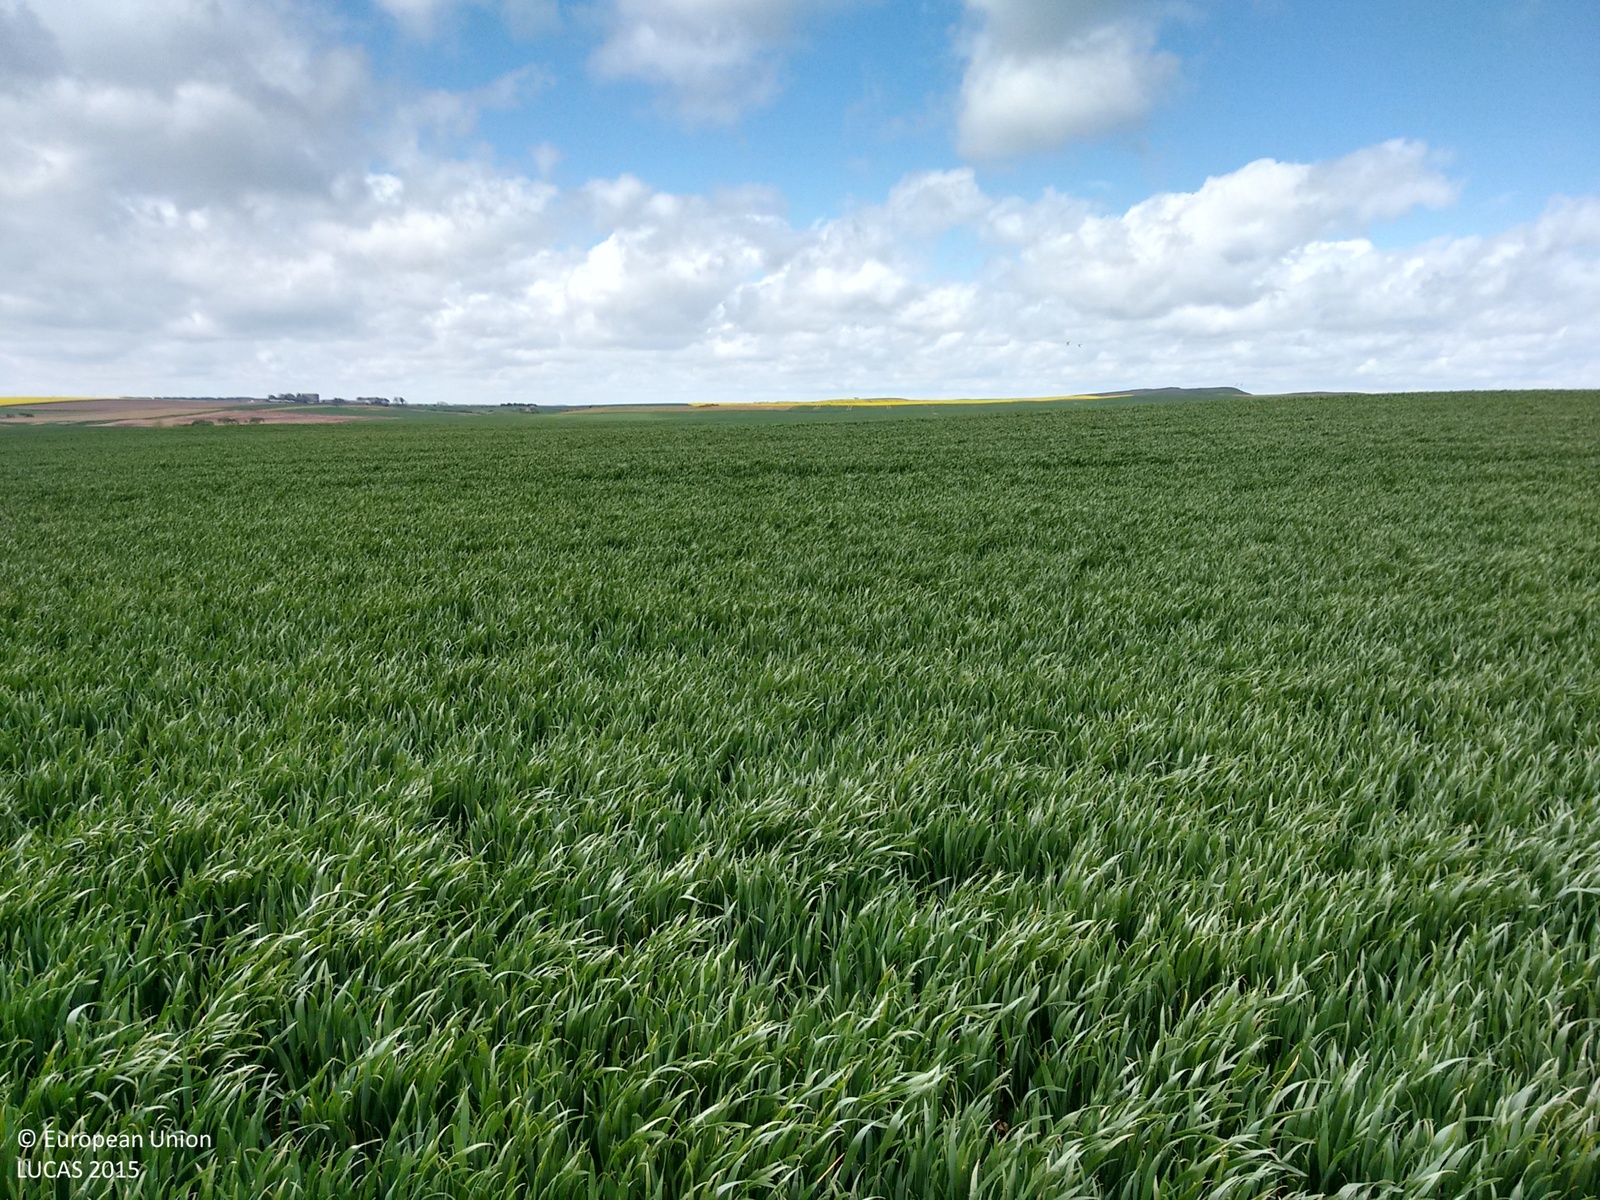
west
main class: Cropland
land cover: Common wheat
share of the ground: > 75 %
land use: Agriculture (excluding fallow land and kitchen gardens)
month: May
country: GB
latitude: 54.1498
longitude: -0.1837
